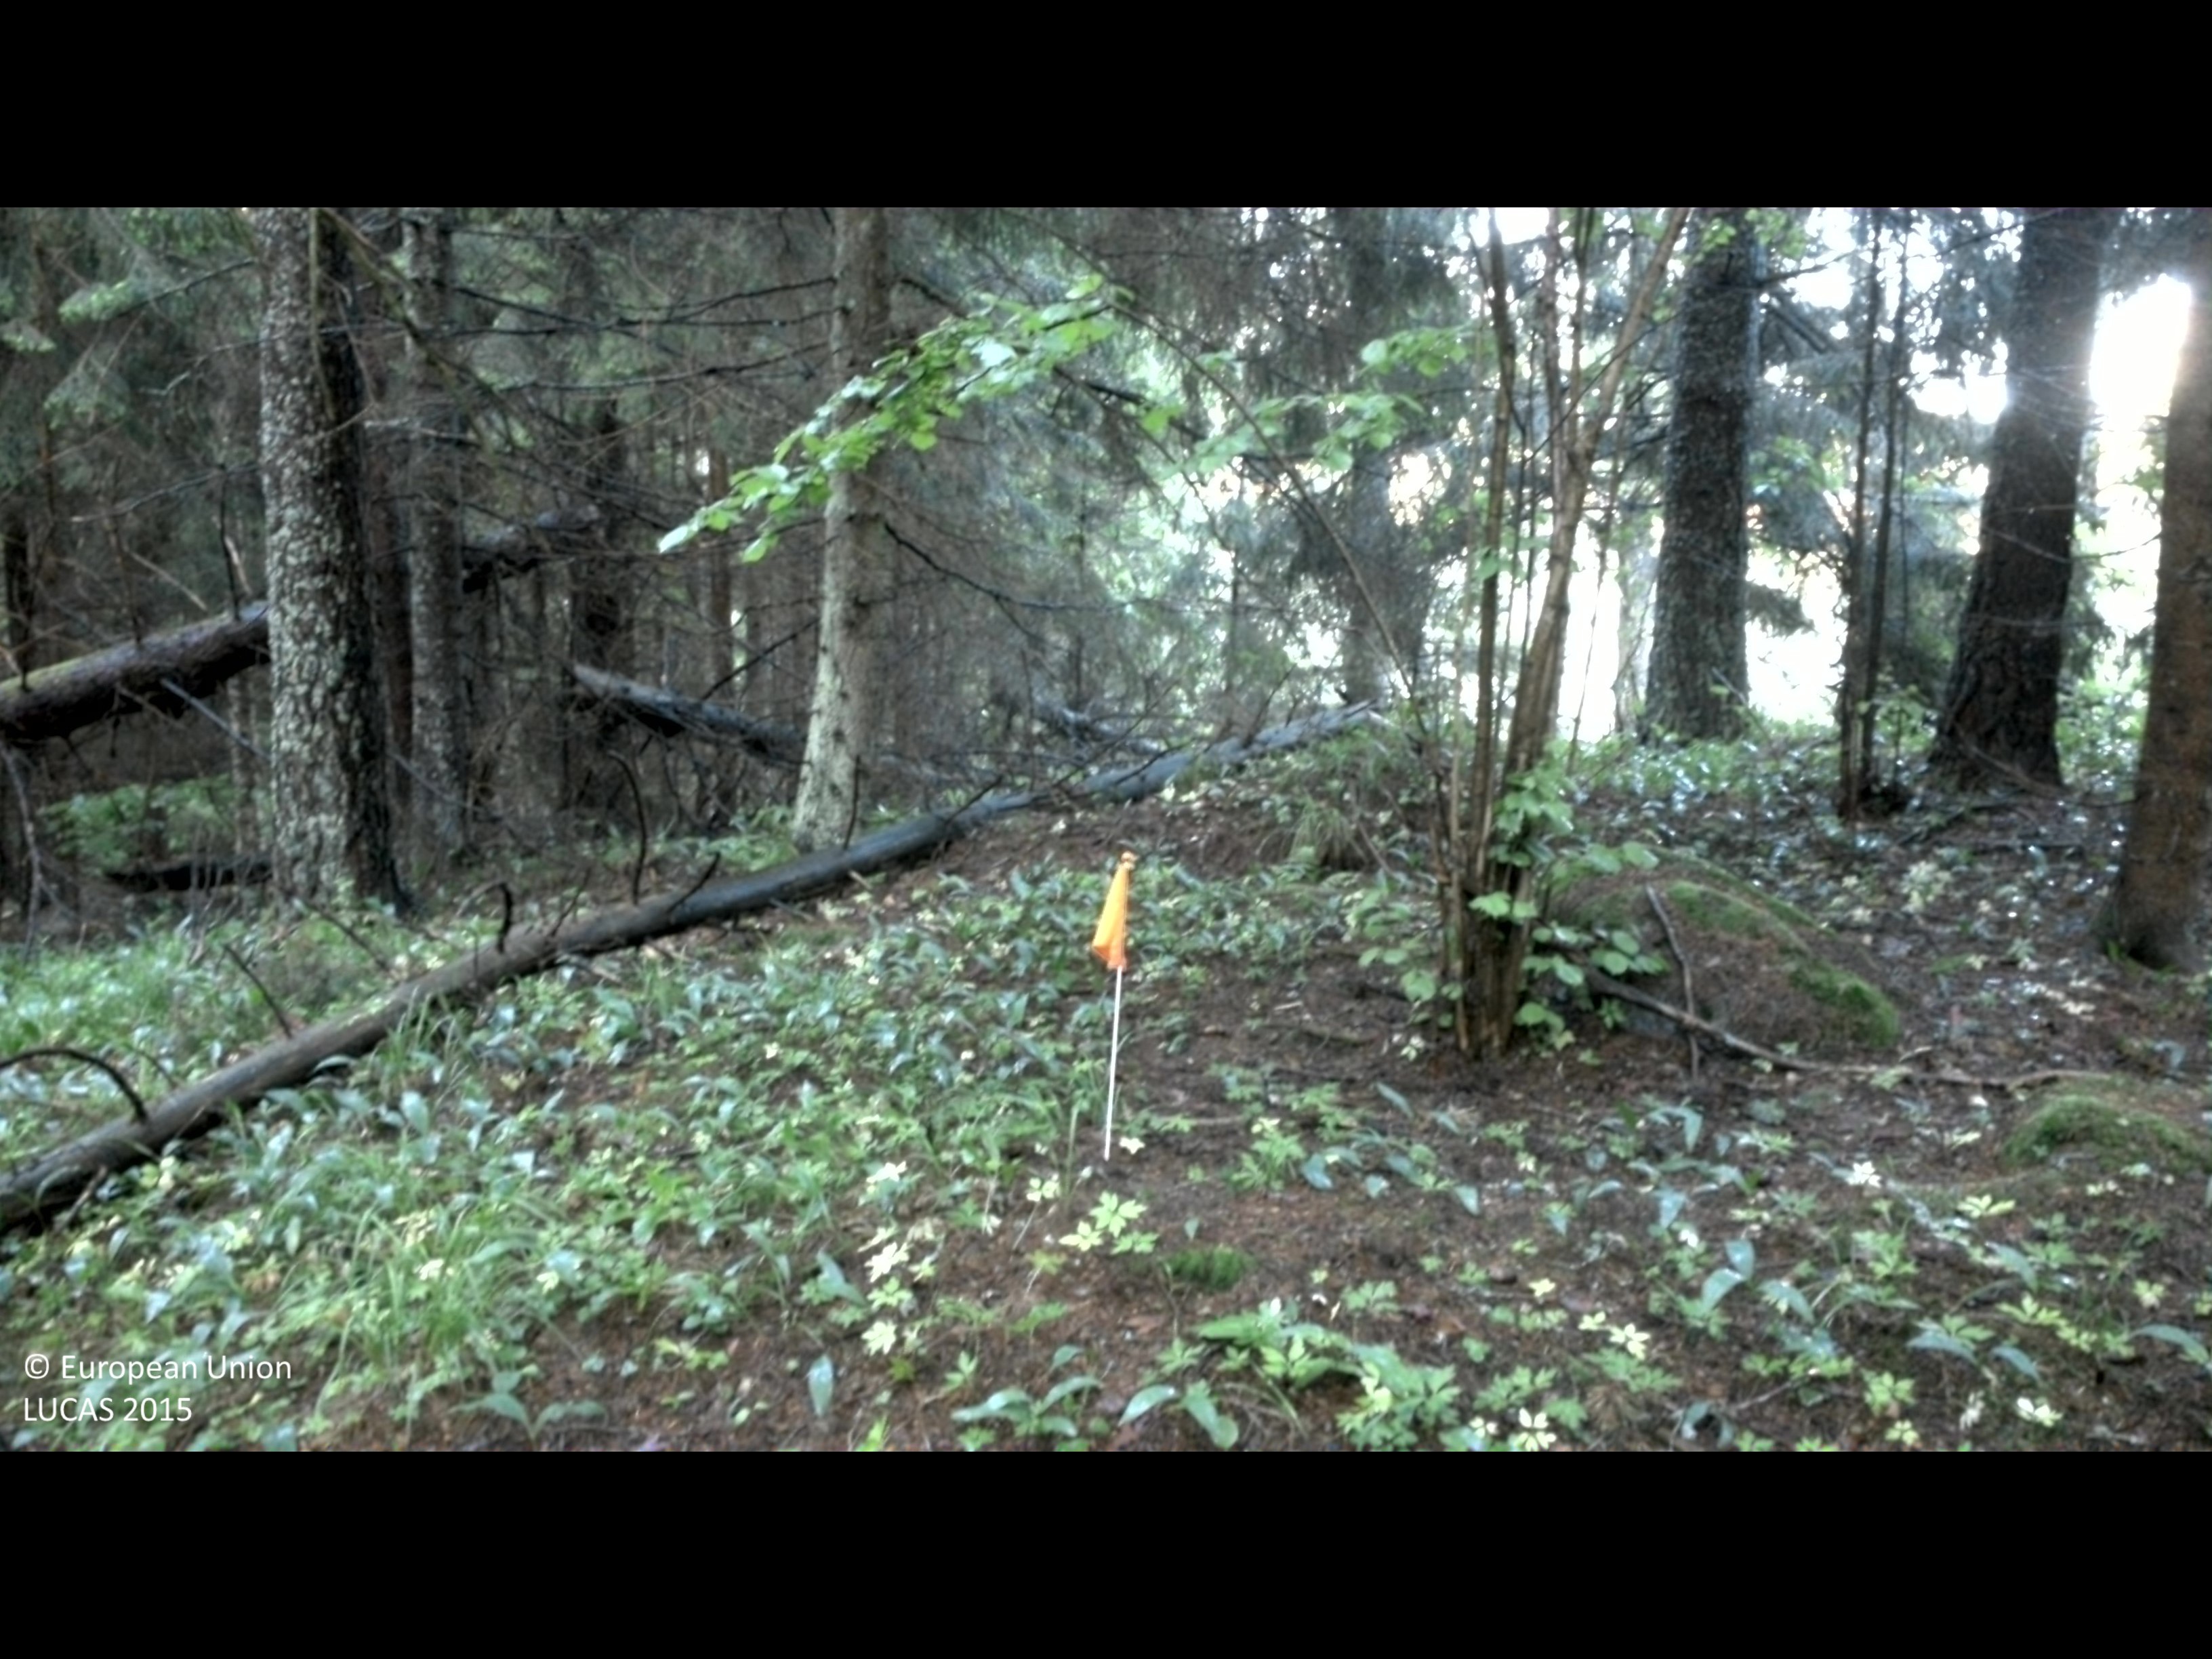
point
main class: Woodland
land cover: Spruce dominated coniferous woodland
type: boreal forest
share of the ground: > 75 %
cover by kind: coniferous forest trees 70 %, broadleaved forest trees 20 %, shrubs 5 %, herbaceous plants 5 %
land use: Forestry
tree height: > 5 m
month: June
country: SE
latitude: 58.0787
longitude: 16.1518
